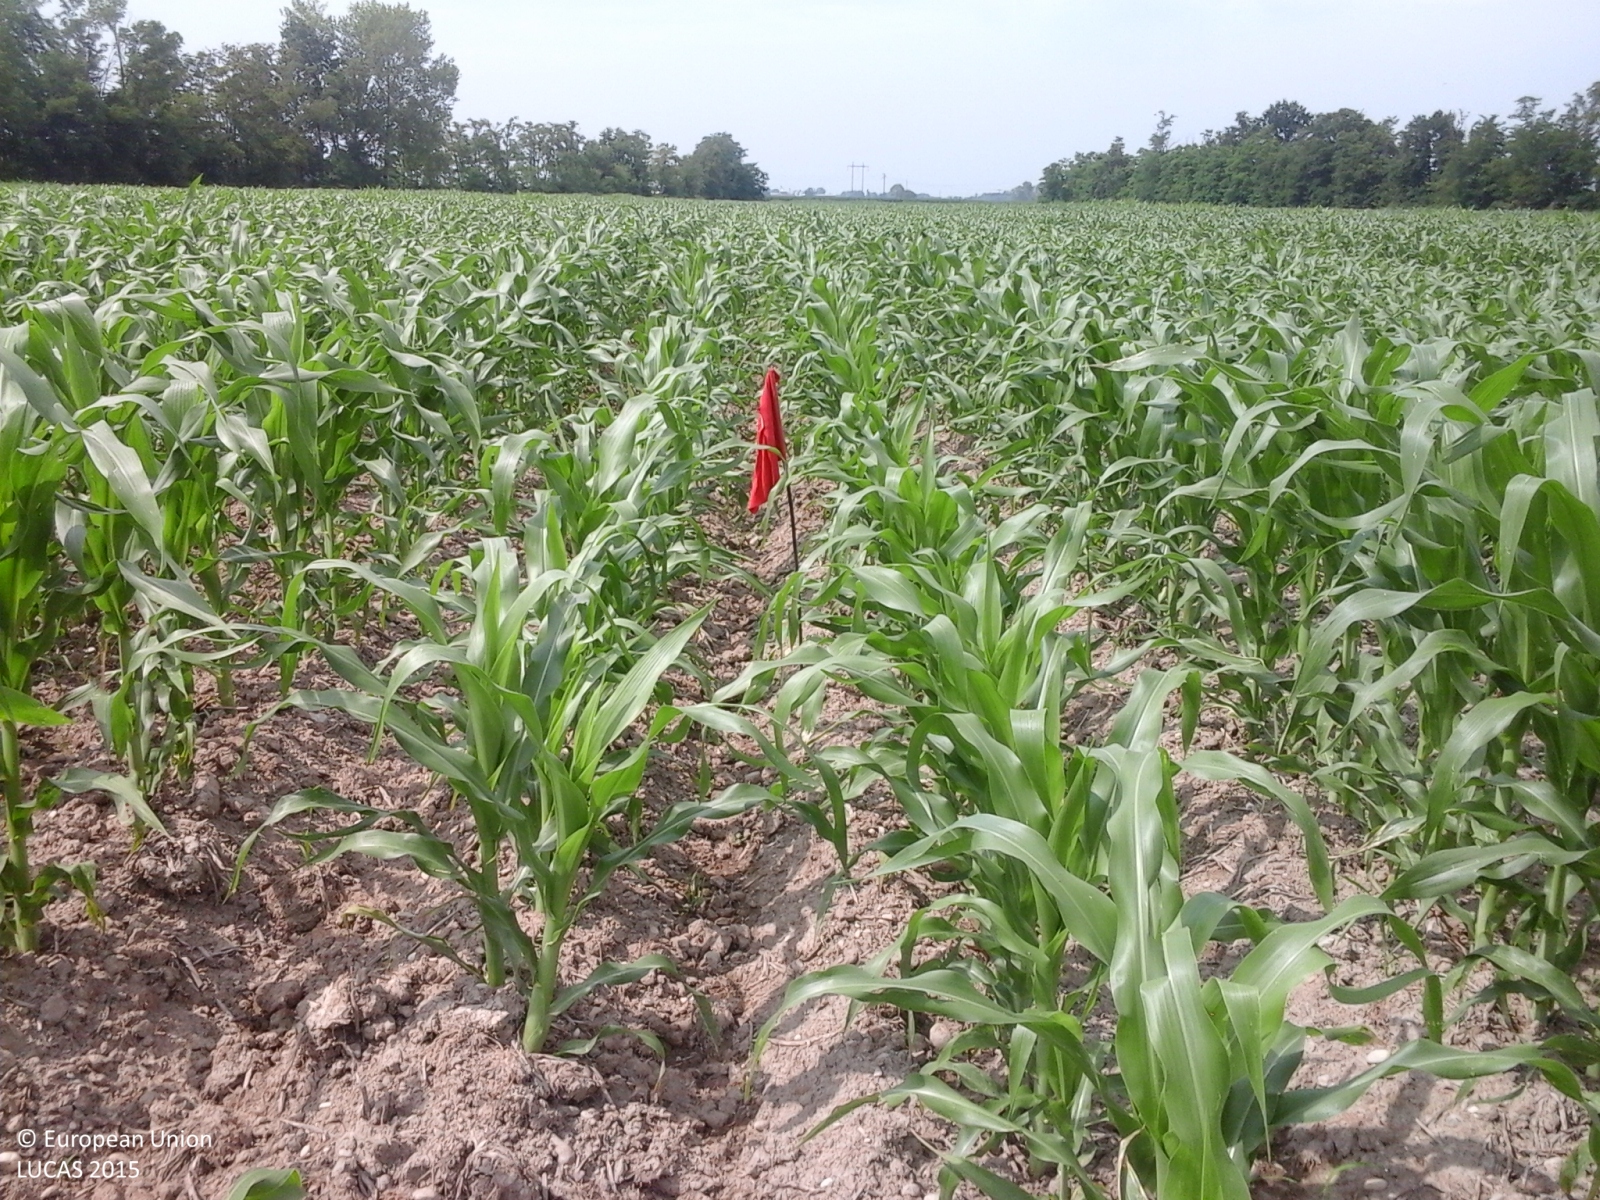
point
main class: Cropland
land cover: Maize
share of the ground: 50 - 75 %
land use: Agriculture (excluding fallow land and kitchen gardens)
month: June
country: IT
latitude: 45.3884
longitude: 8.7122
